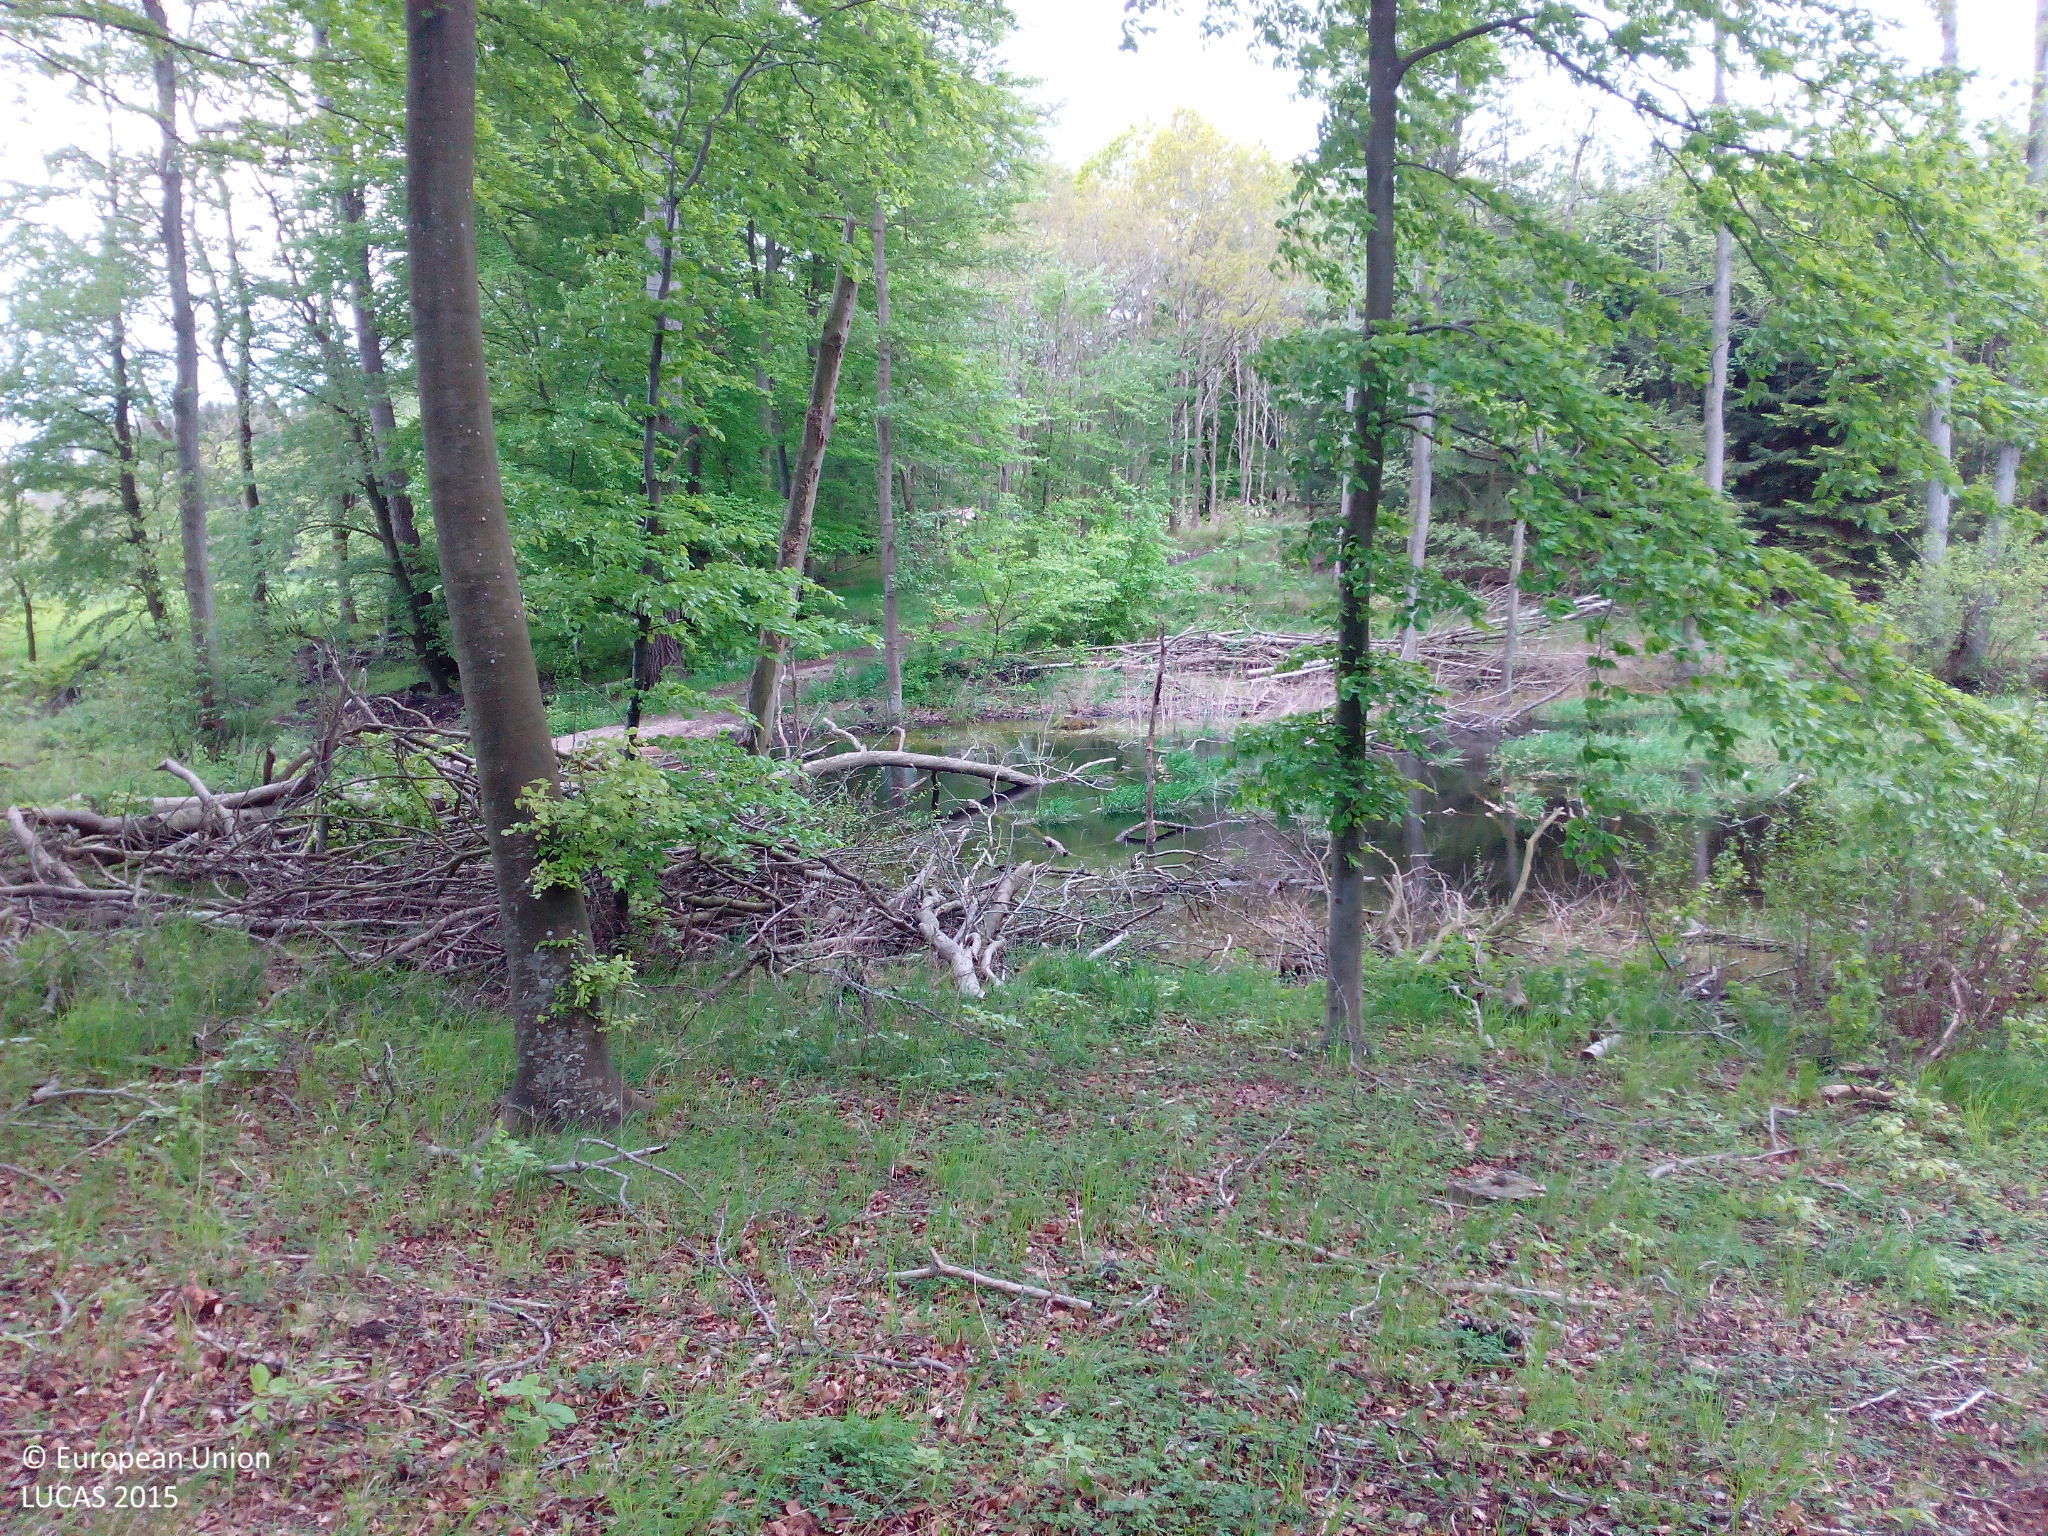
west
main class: Woodland
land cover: Broadleaved woodland
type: beech forest
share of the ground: > 75 %
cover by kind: broadleaved forest trees 95 %, herbaceous plants 5 %
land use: Forestry
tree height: > 5 m
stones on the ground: < 10 %
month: May
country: DK
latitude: 55.6340
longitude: 11.9204
